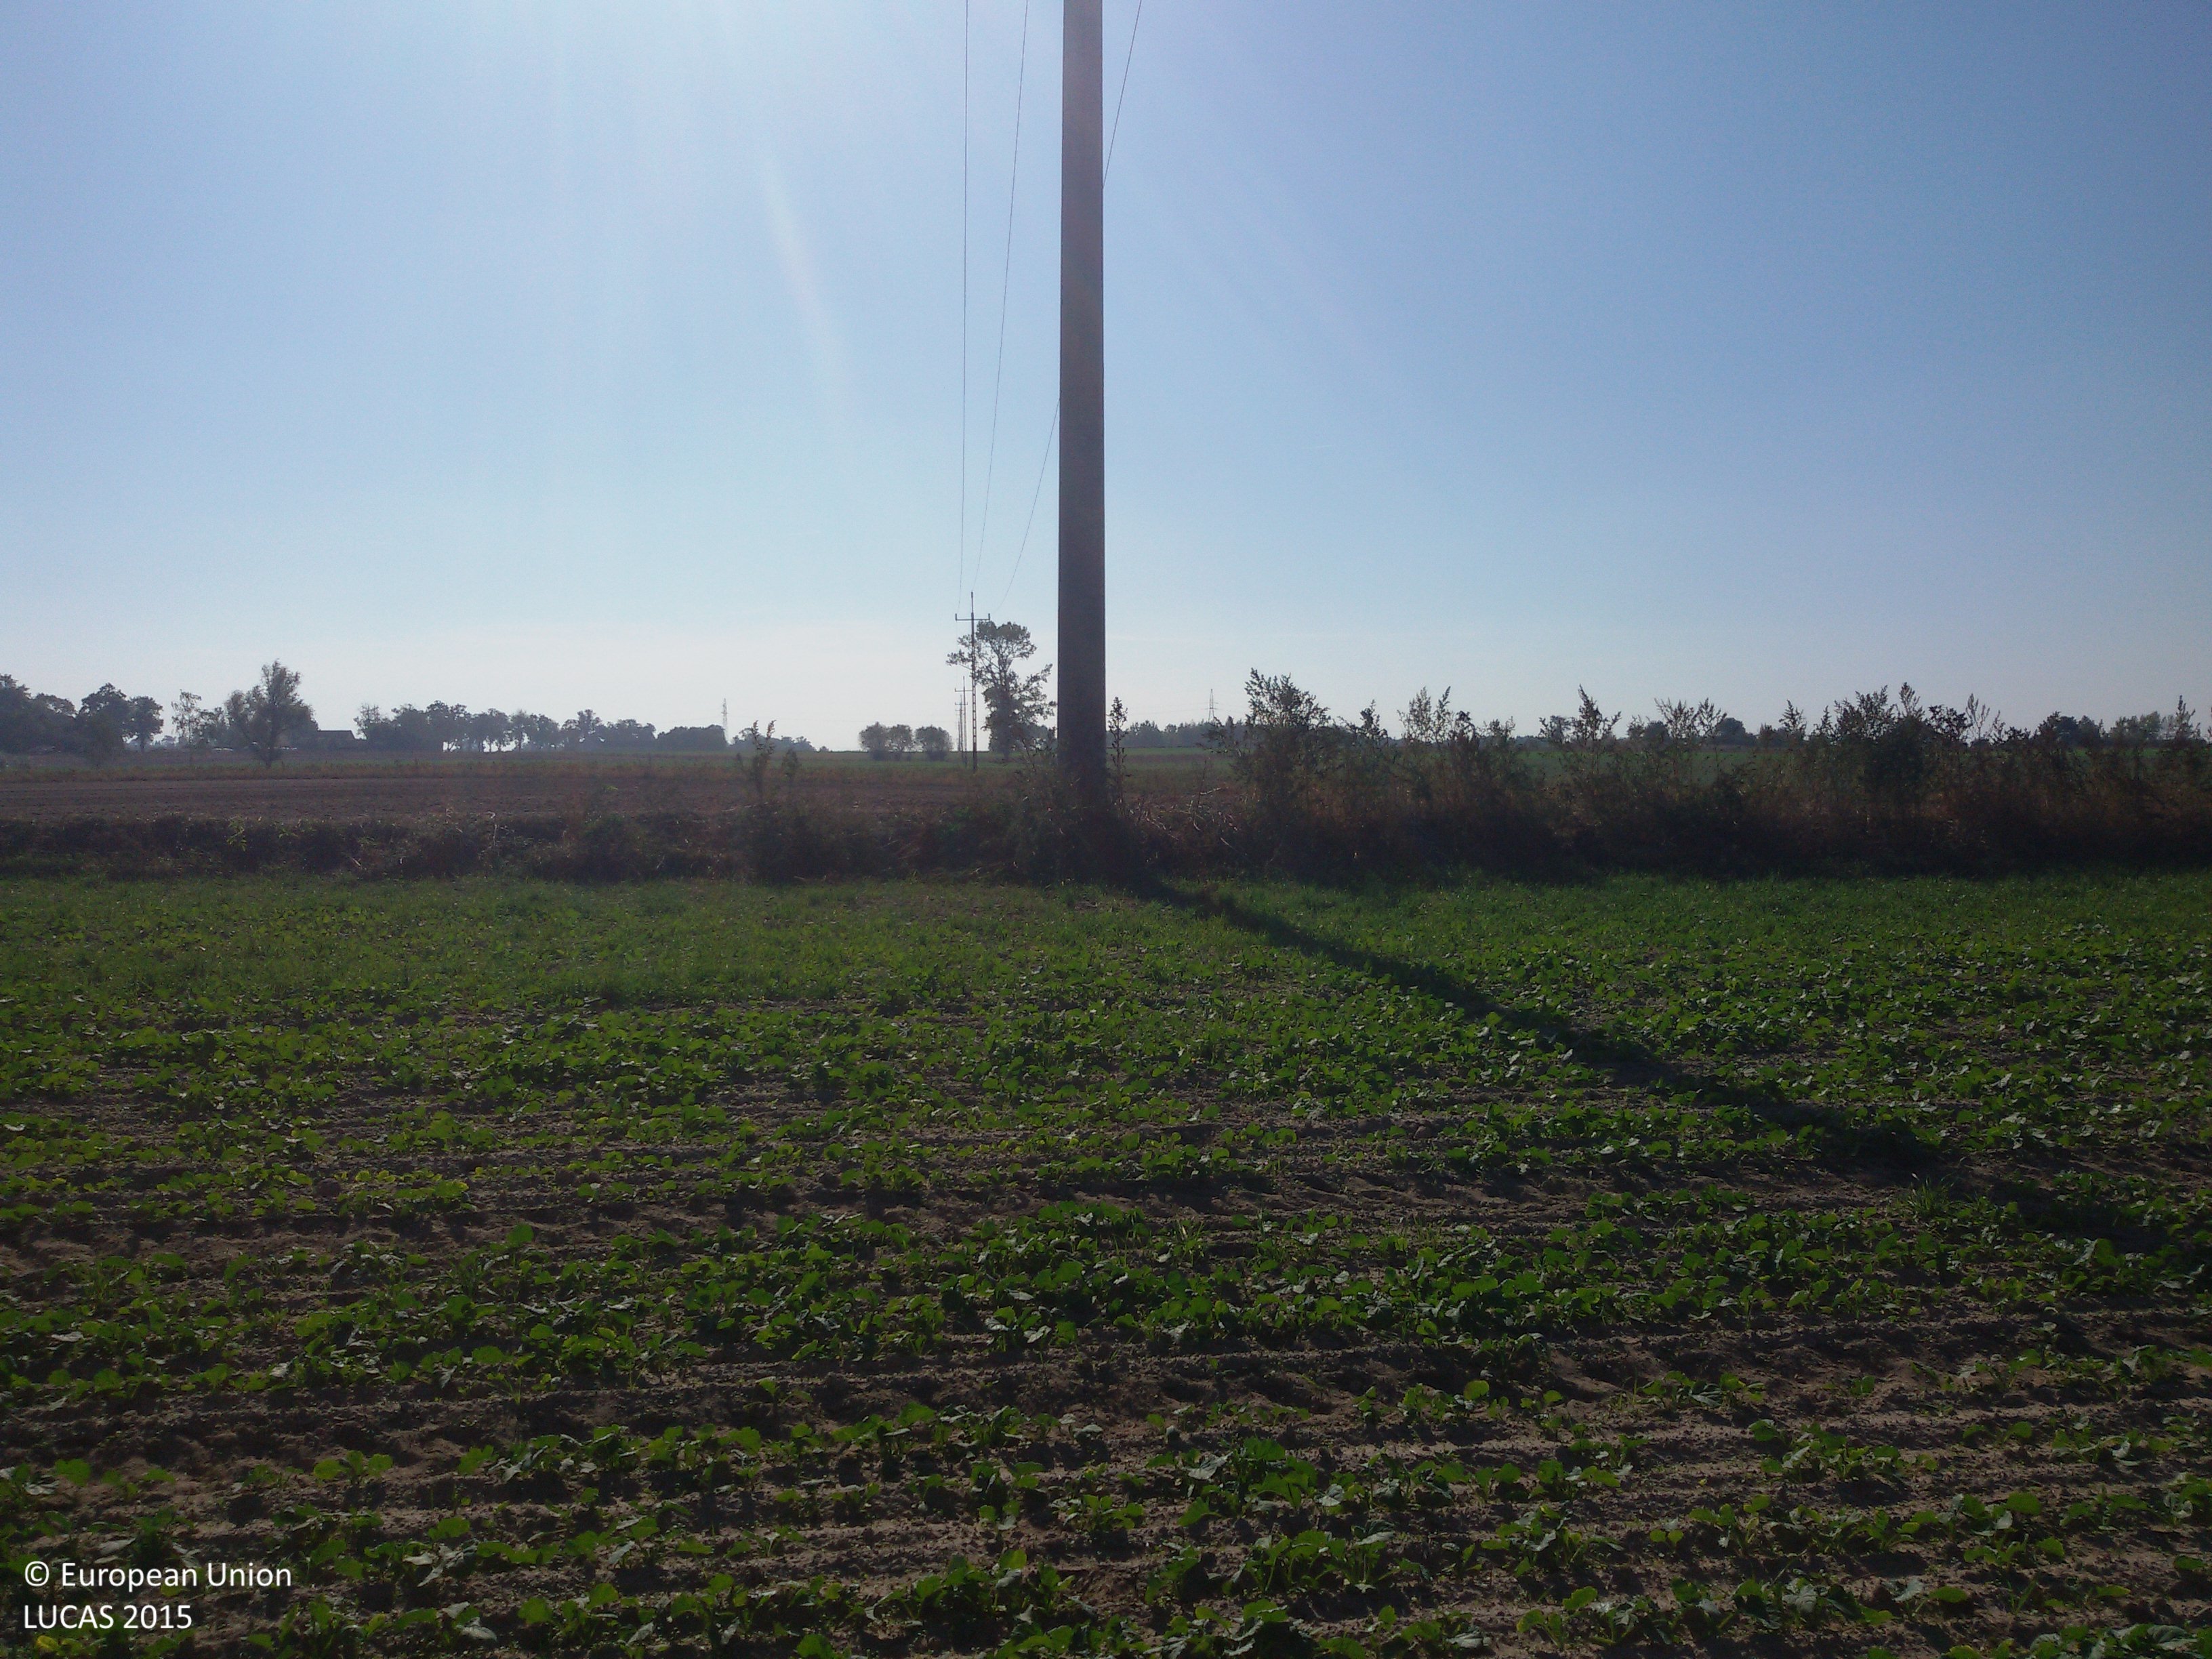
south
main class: Cropland
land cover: Rape and turnip rape
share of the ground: > 75 %
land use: Agriculture (excluding fallow land and kitchen gardens)
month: October
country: PL
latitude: 52.5751
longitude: 18.0282
